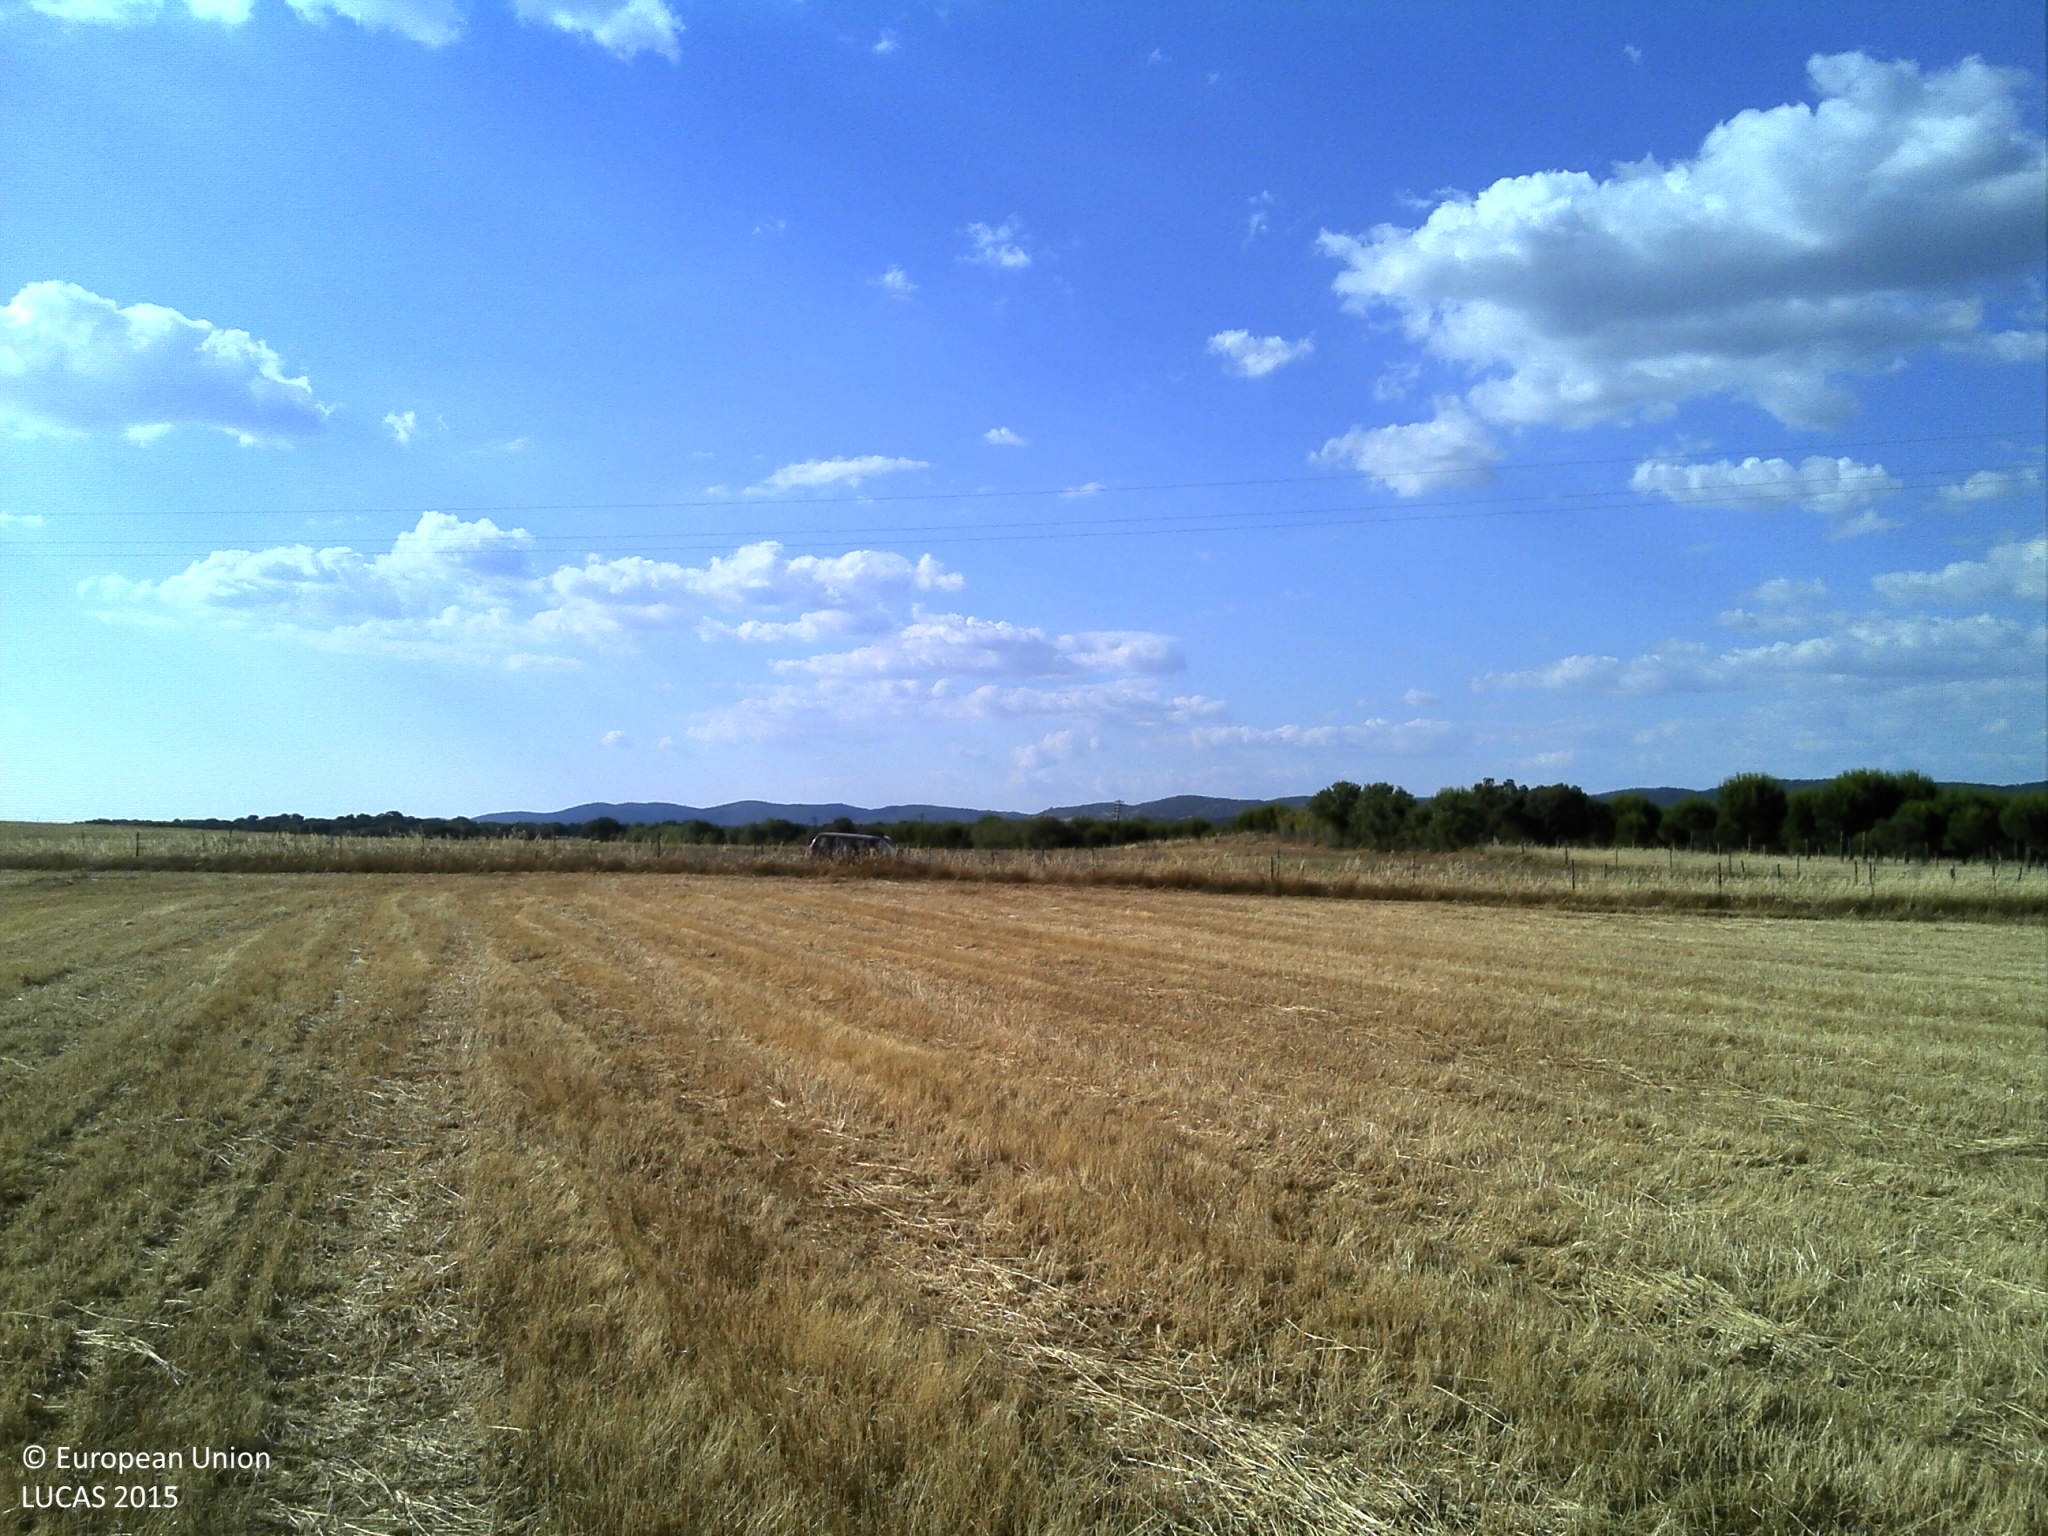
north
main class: Cropland
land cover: Temporary grasslands
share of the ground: 10 - 25 %
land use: Agriculture (excluding fallow land and kitchen gardens)
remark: Harvested field
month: June
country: PT
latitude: 38.4852
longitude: -8.1454
